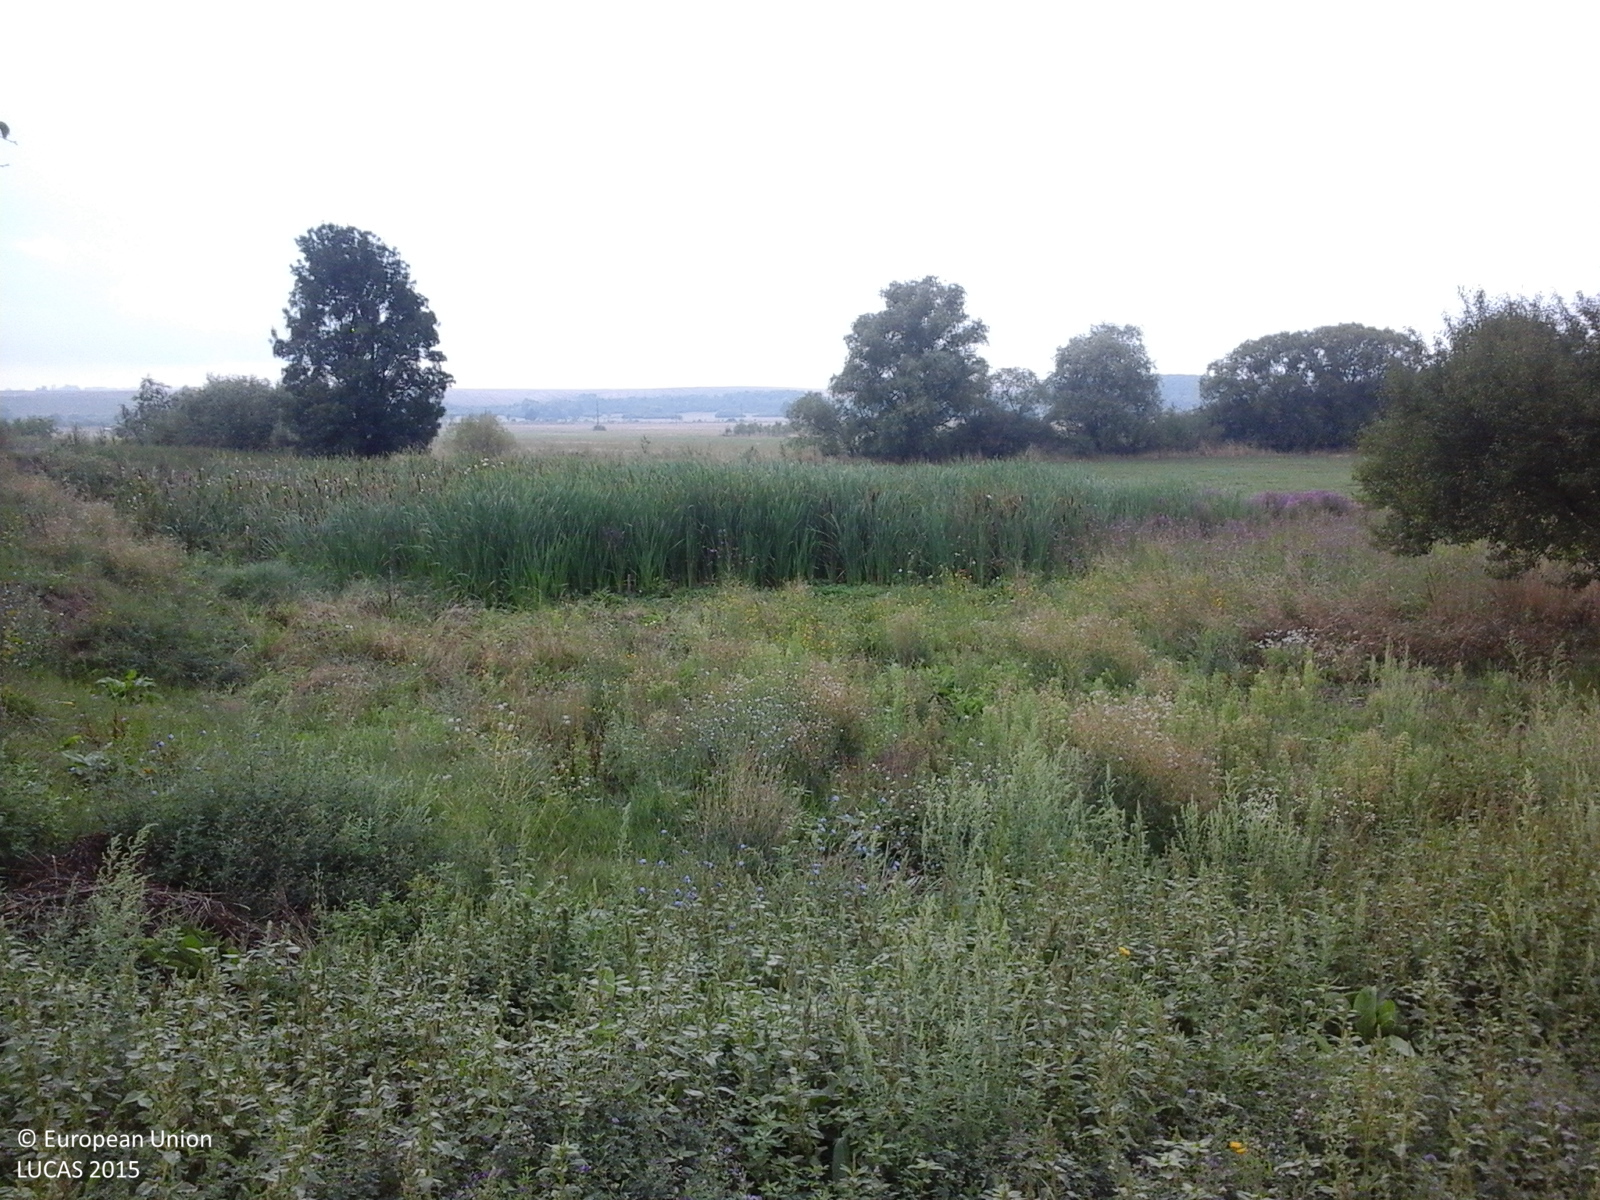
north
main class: Cropland
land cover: Lucerne
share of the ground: > 75 %
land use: Agriculture (excluding fallow land and kitchen gardens)
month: August
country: RO
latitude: 45.9672
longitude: 21.4813
